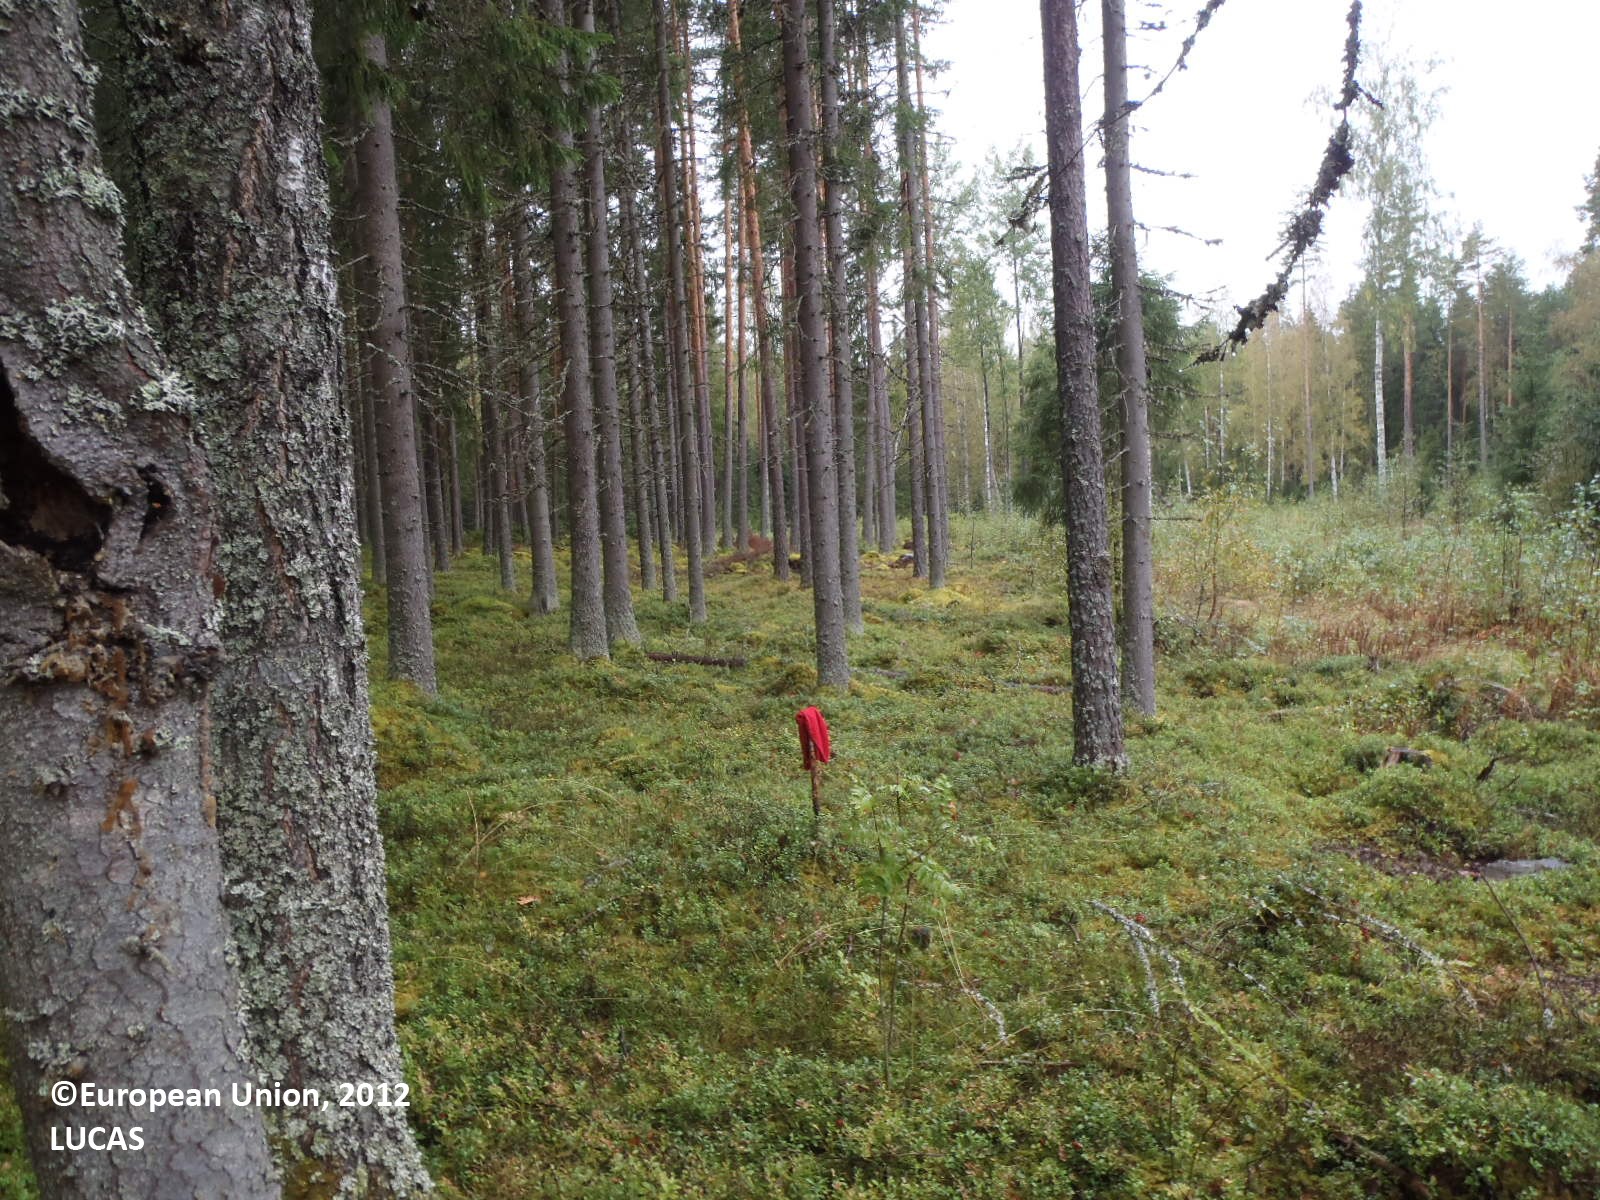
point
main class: Woodland
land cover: Spruce dominated coniferous woodland
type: boreal forest
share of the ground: > 75 %
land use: Forestry
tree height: > 5 m
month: September
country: FI
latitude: 61.5519
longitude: 22.5782
